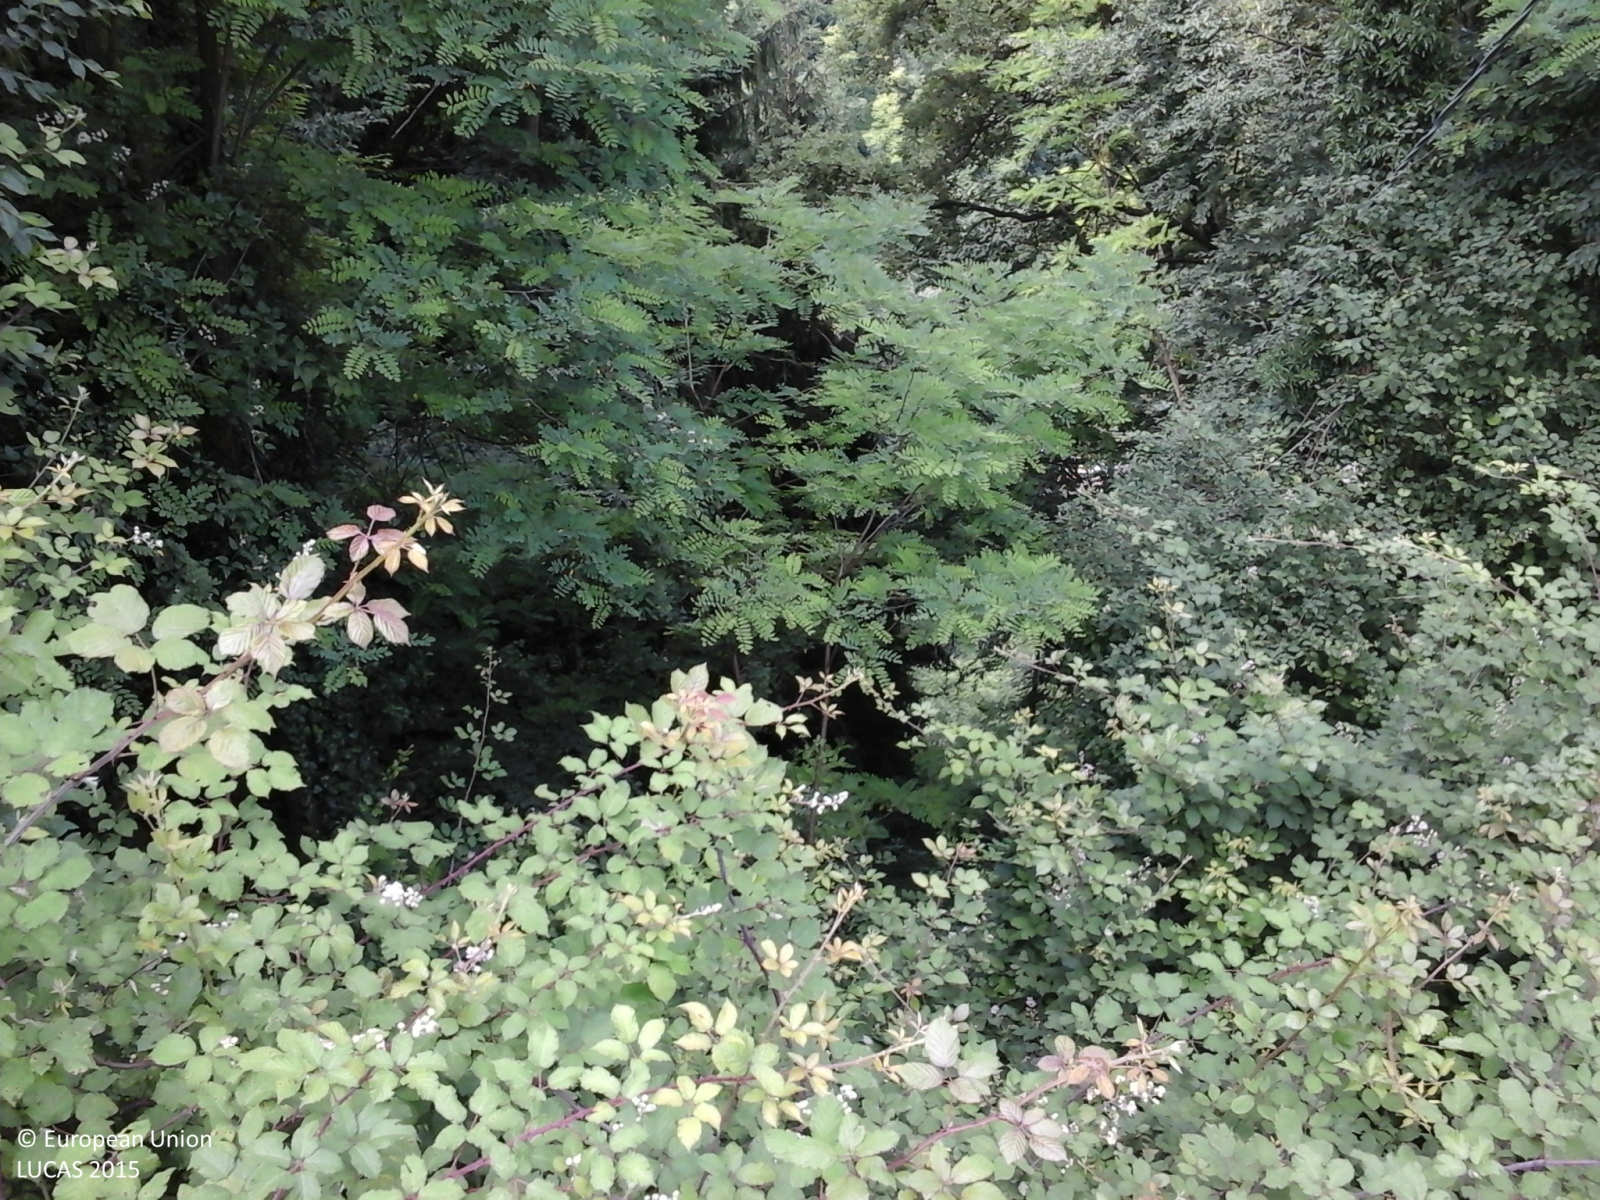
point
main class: Woodland
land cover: Broadleaved woodland
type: thermophilous deciduous forest
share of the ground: > 75 %
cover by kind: broadleaved forest trees 100 %
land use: Semi-natural and natural areas not in use
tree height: > 5 m
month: June
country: IT
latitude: 45.6845
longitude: 10.1154
